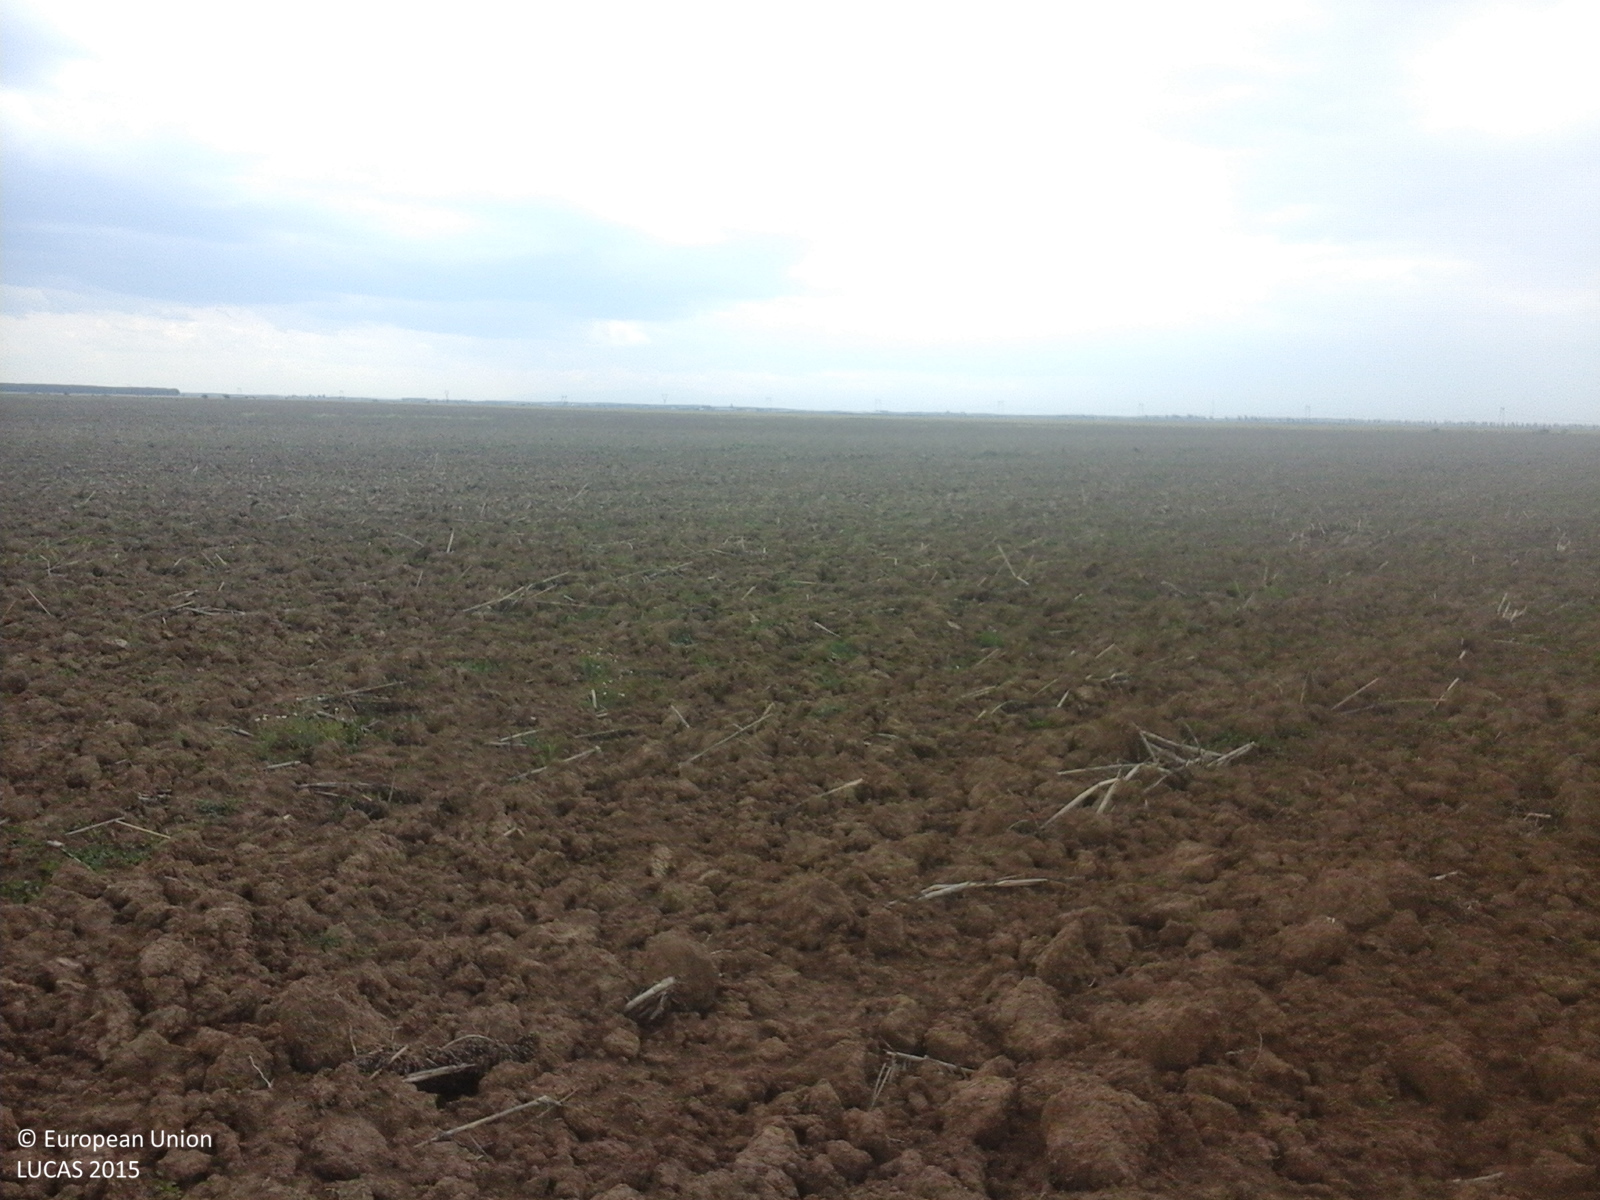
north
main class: Cropland
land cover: Other cereals
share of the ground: < 10 %
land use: Agriculture (excluding fallow land and kitchen gardens)
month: July
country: RO
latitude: 44.4805
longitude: 25.4931
